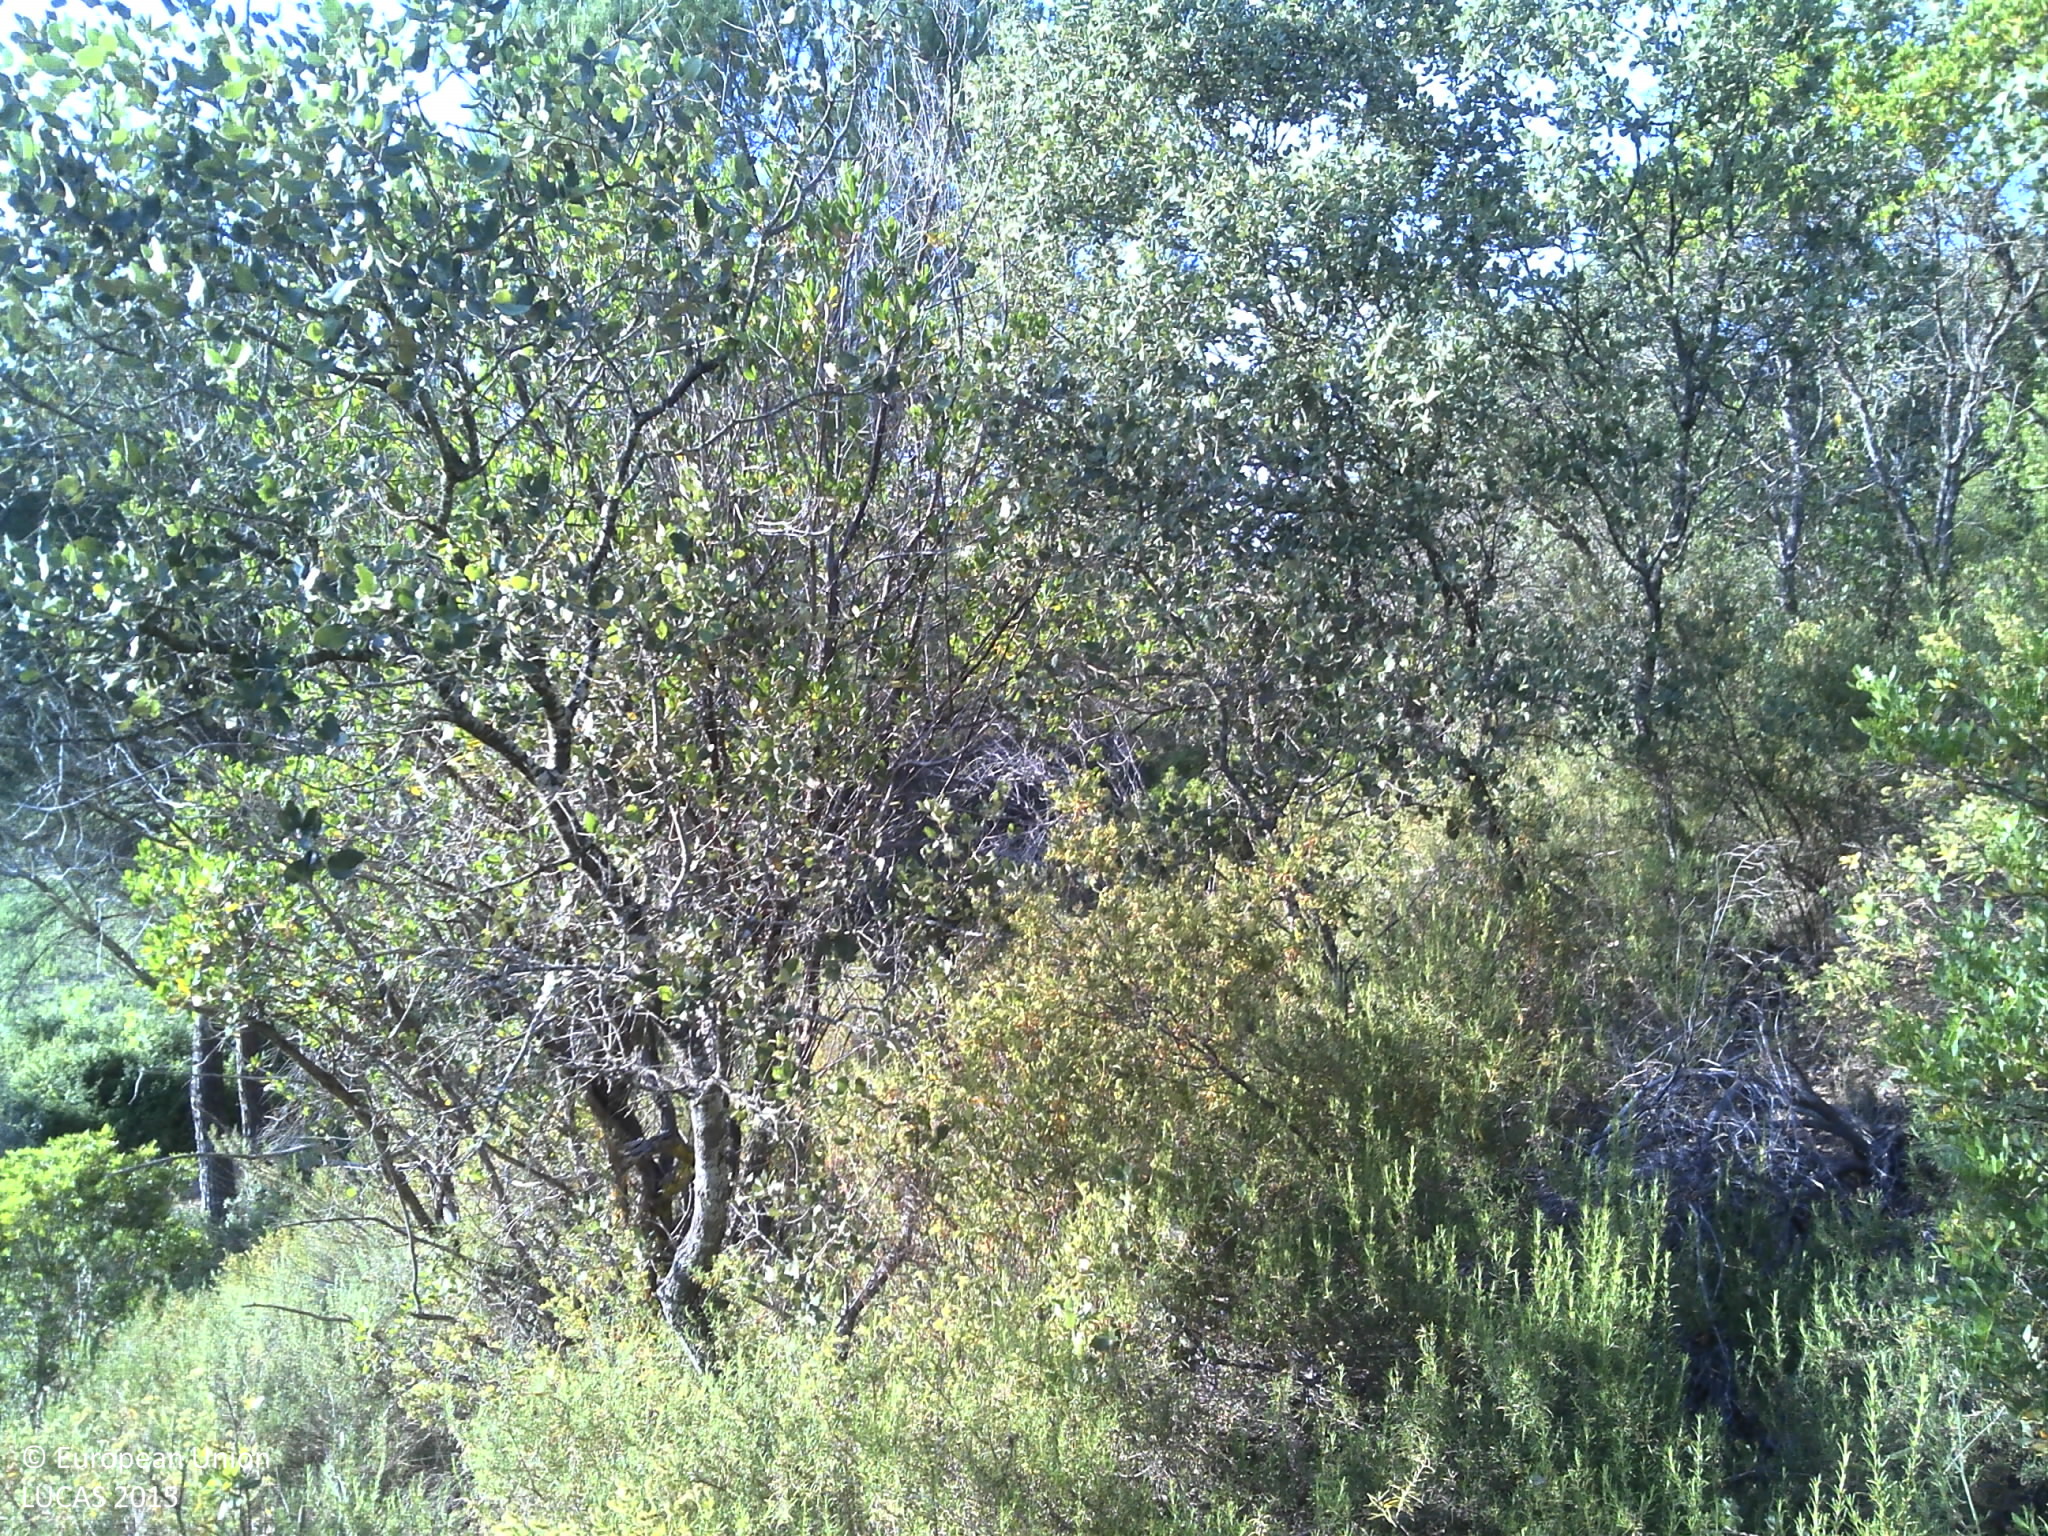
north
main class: Woodland
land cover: Broadleaved woodland
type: broadleaved evergreen forest
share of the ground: 25 - 50 %
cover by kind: shrubs 50 %, broadleaved forest trees 30 %, unconsolidated bare surface 15 %, coniferous forest trees 5 %
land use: Forestry
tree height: > 5 m
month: May
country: PT
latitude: 38.1045
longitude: -8.3917
